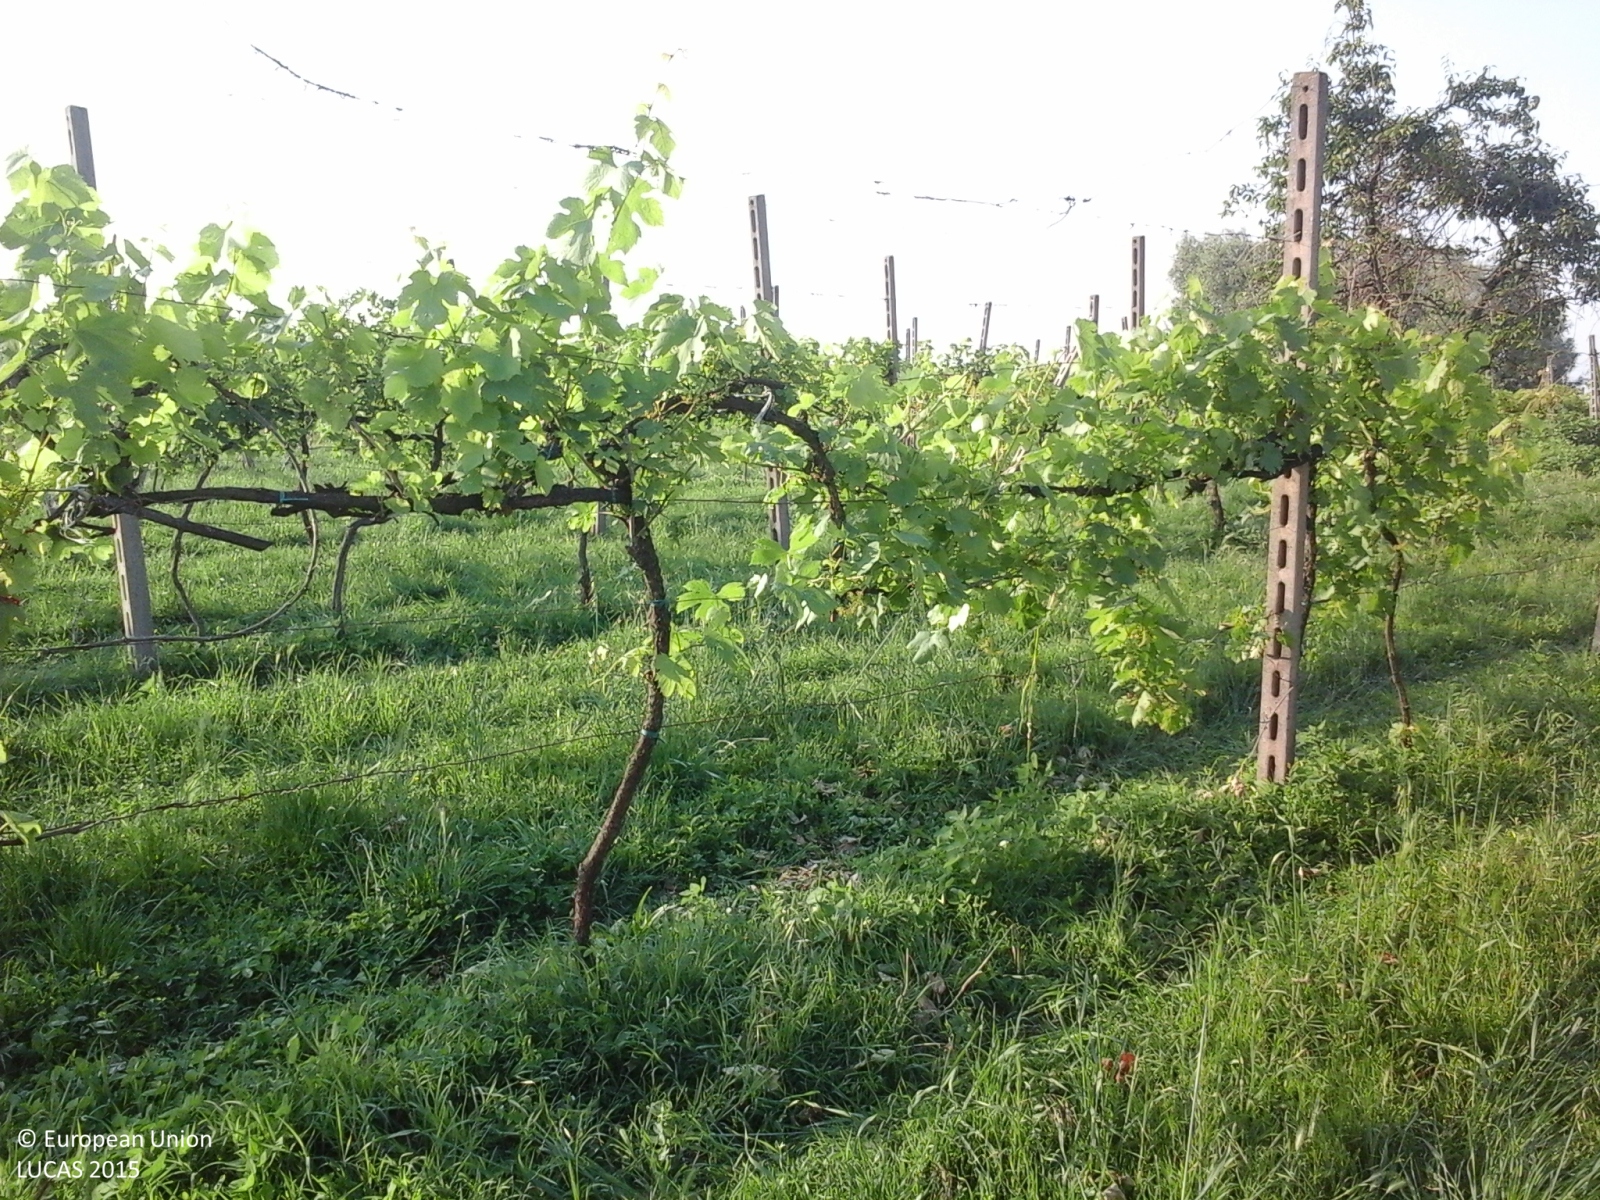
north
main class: Cropland
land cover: Vineyards
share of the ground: 25 - 50 %
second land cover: Grassland without tree/shrub cover
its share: > 75 %
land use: Agriculture (excluding fallow land and kitchen gardens)
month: May
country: IT
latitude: 45.2124
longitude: 10.8770
